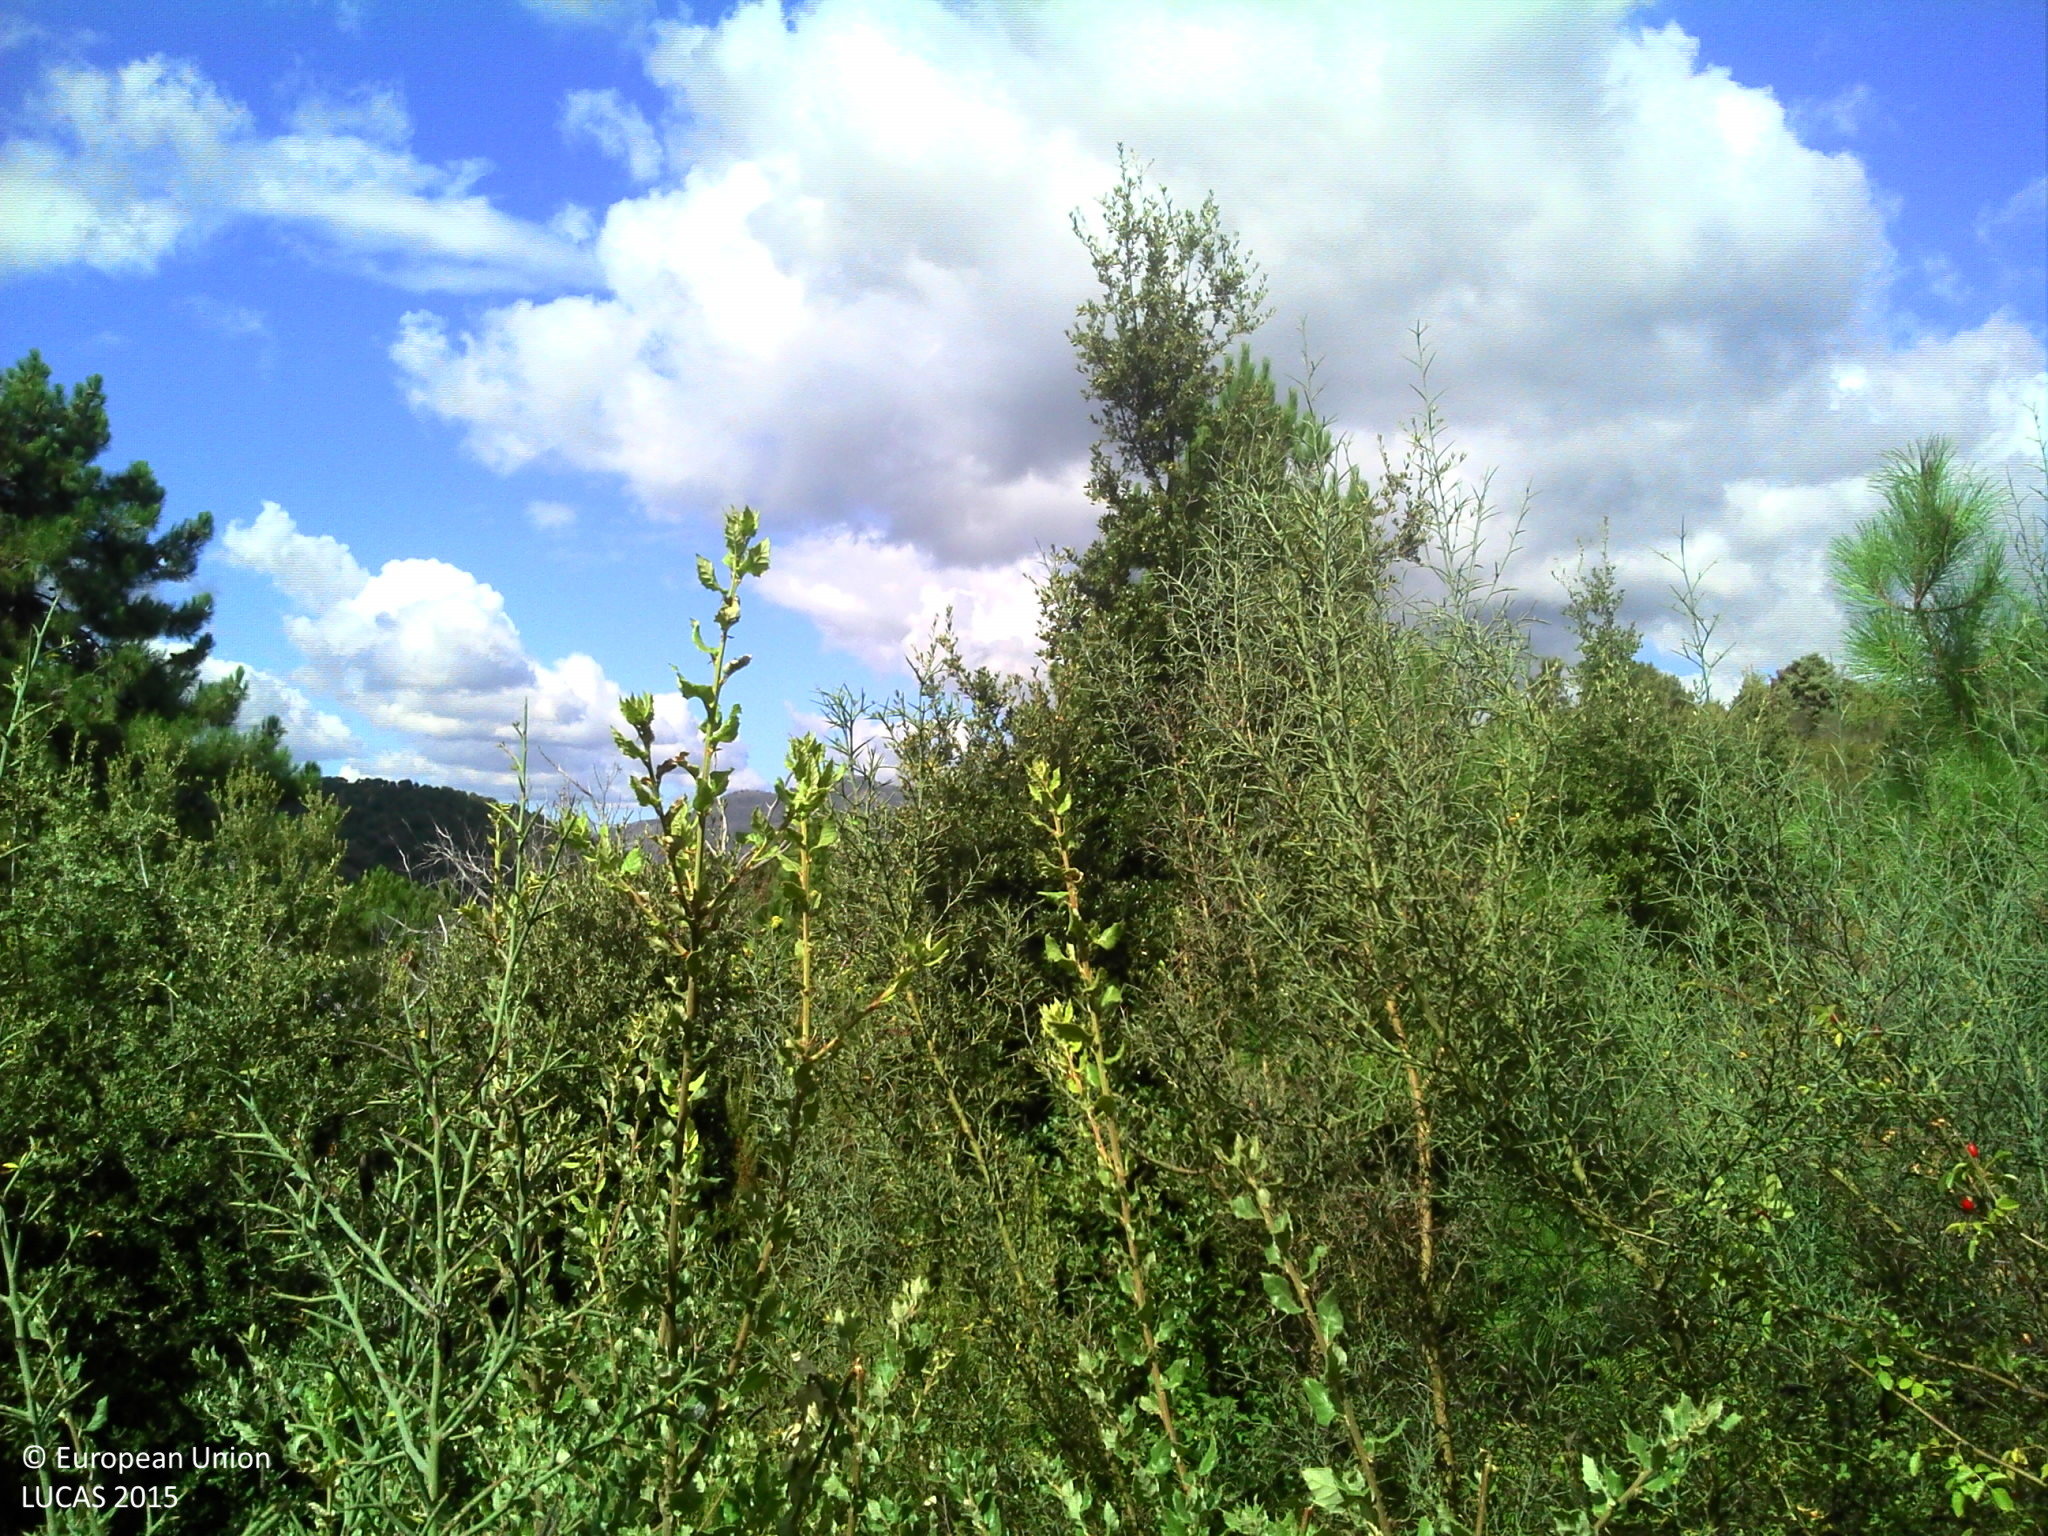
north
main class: Shrubland
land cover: Shrubland with sparse tree cover
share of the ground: > 75 %
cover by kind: shrubs 95 %, broadleaved forest trees 5 %
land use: Semi-natural and natural areas not in use
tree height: < 5 m
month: September
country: FR
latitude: 42.4347
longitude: 9.2853
